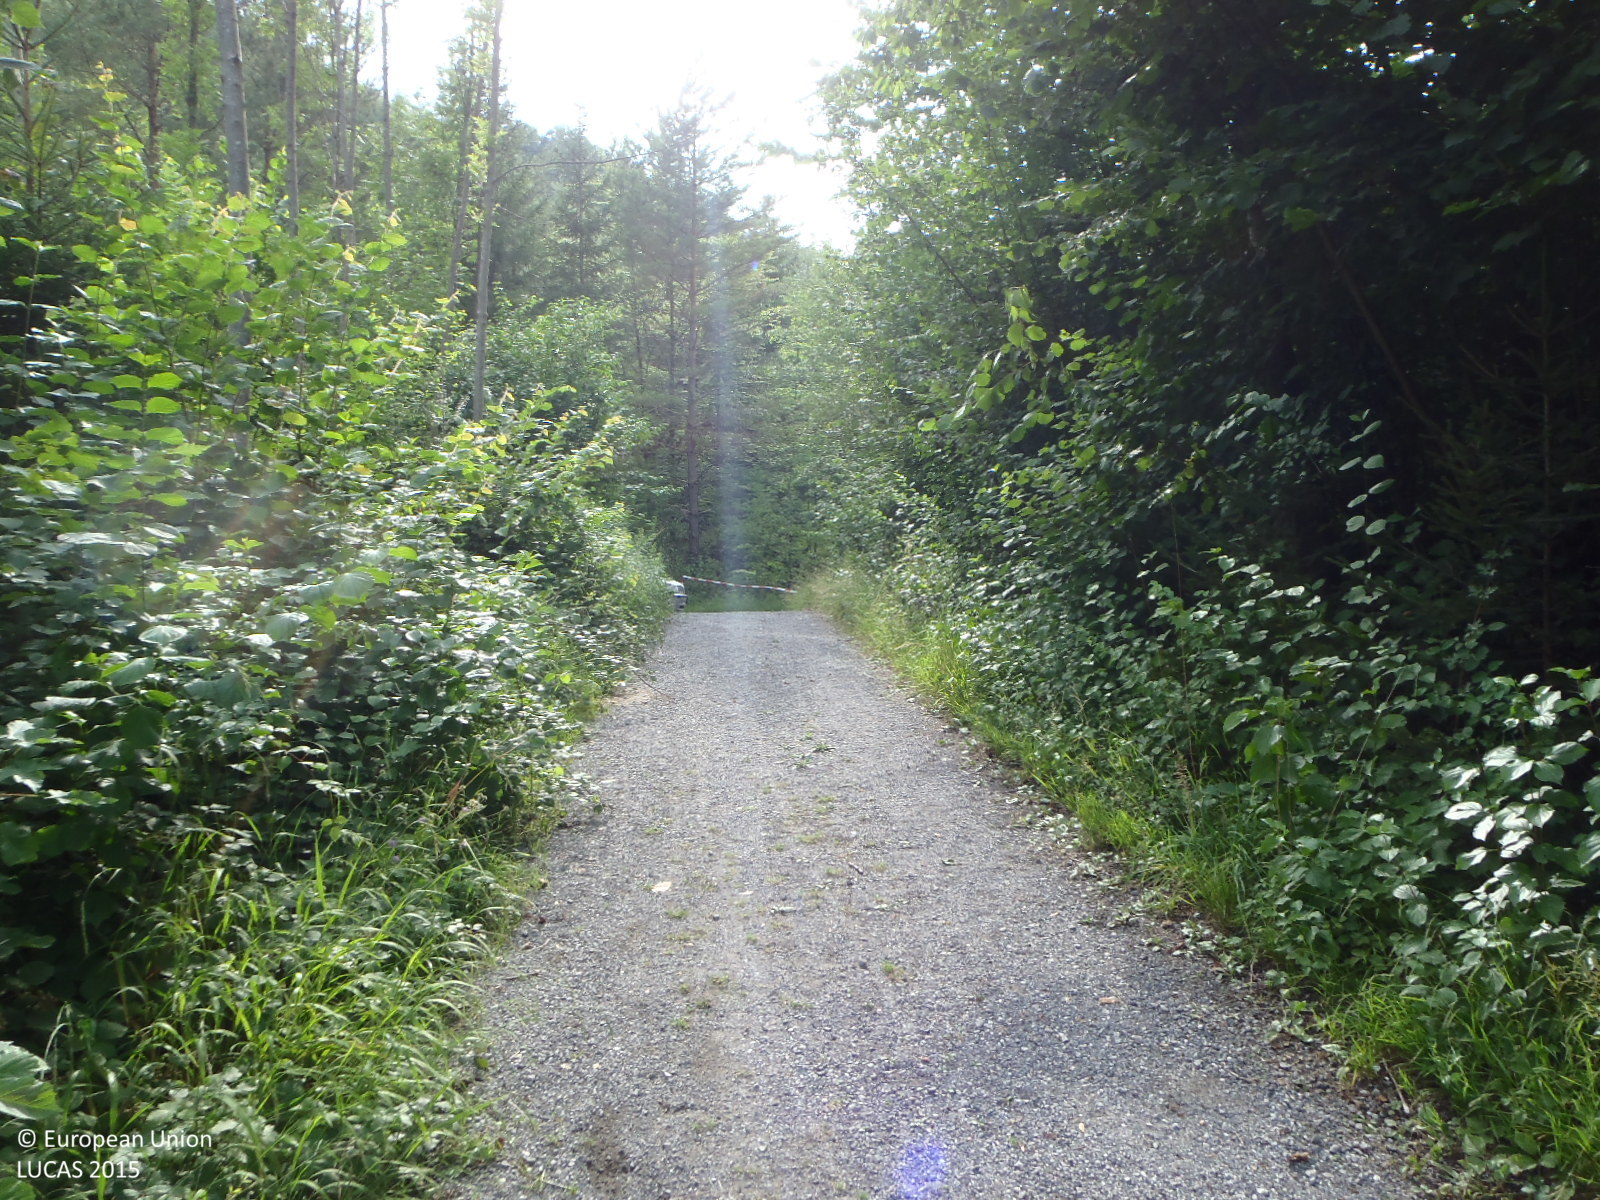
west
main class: Woodland
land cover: Broadleaved woodland
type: mountainous beech forest
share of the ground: > 75 %
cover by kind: broadleaved forest trees 50 %, shrubs 30 %, herbaceous plants 20 %
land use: Forestry
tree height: > 5 m
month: July
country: AT
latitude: 47.1971
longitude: 9.6703
